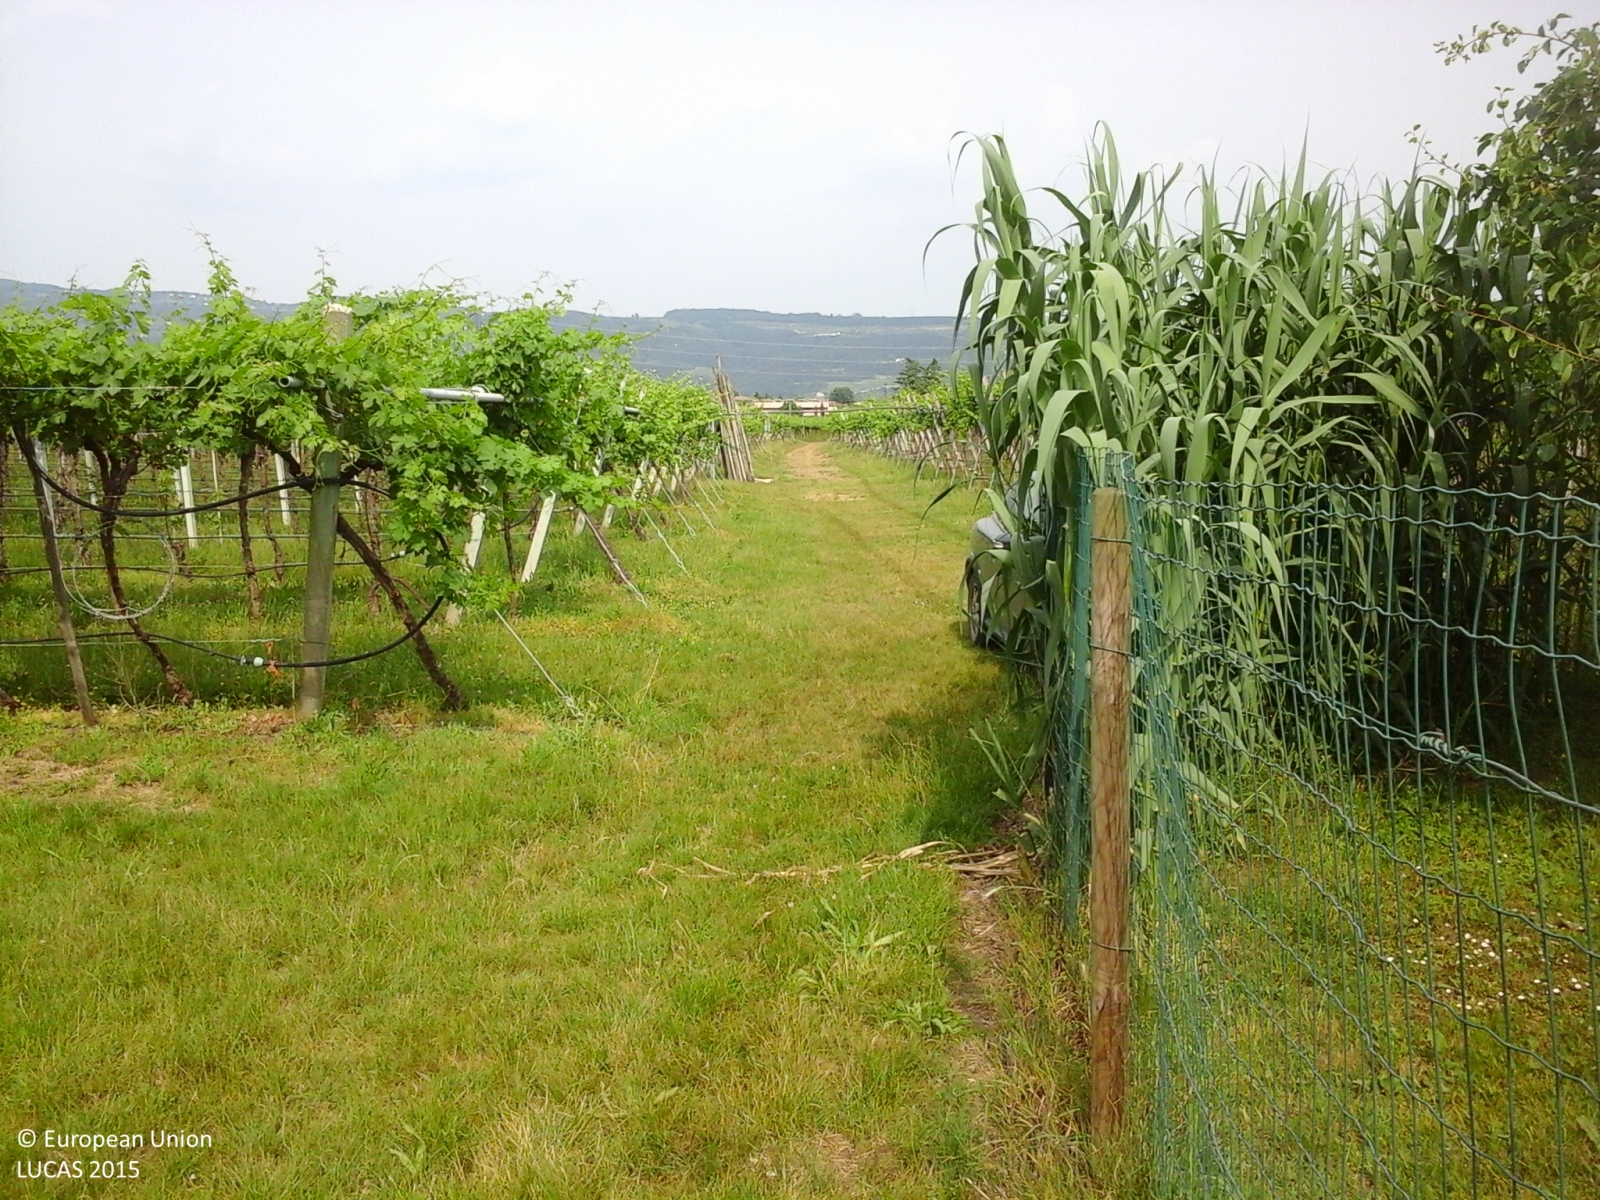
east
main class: Cropland
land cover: Potatoes
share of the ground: > 75 %
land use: Agriculture (excluding fallow land and kitchen gardens)
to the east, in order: Potatoes; Cherry fruit; Vineyards; Fences; Vineyards; Fences; Tracks; Fences; Vineyards
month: June
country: IT
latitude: 45.5005
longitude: 10.9071
